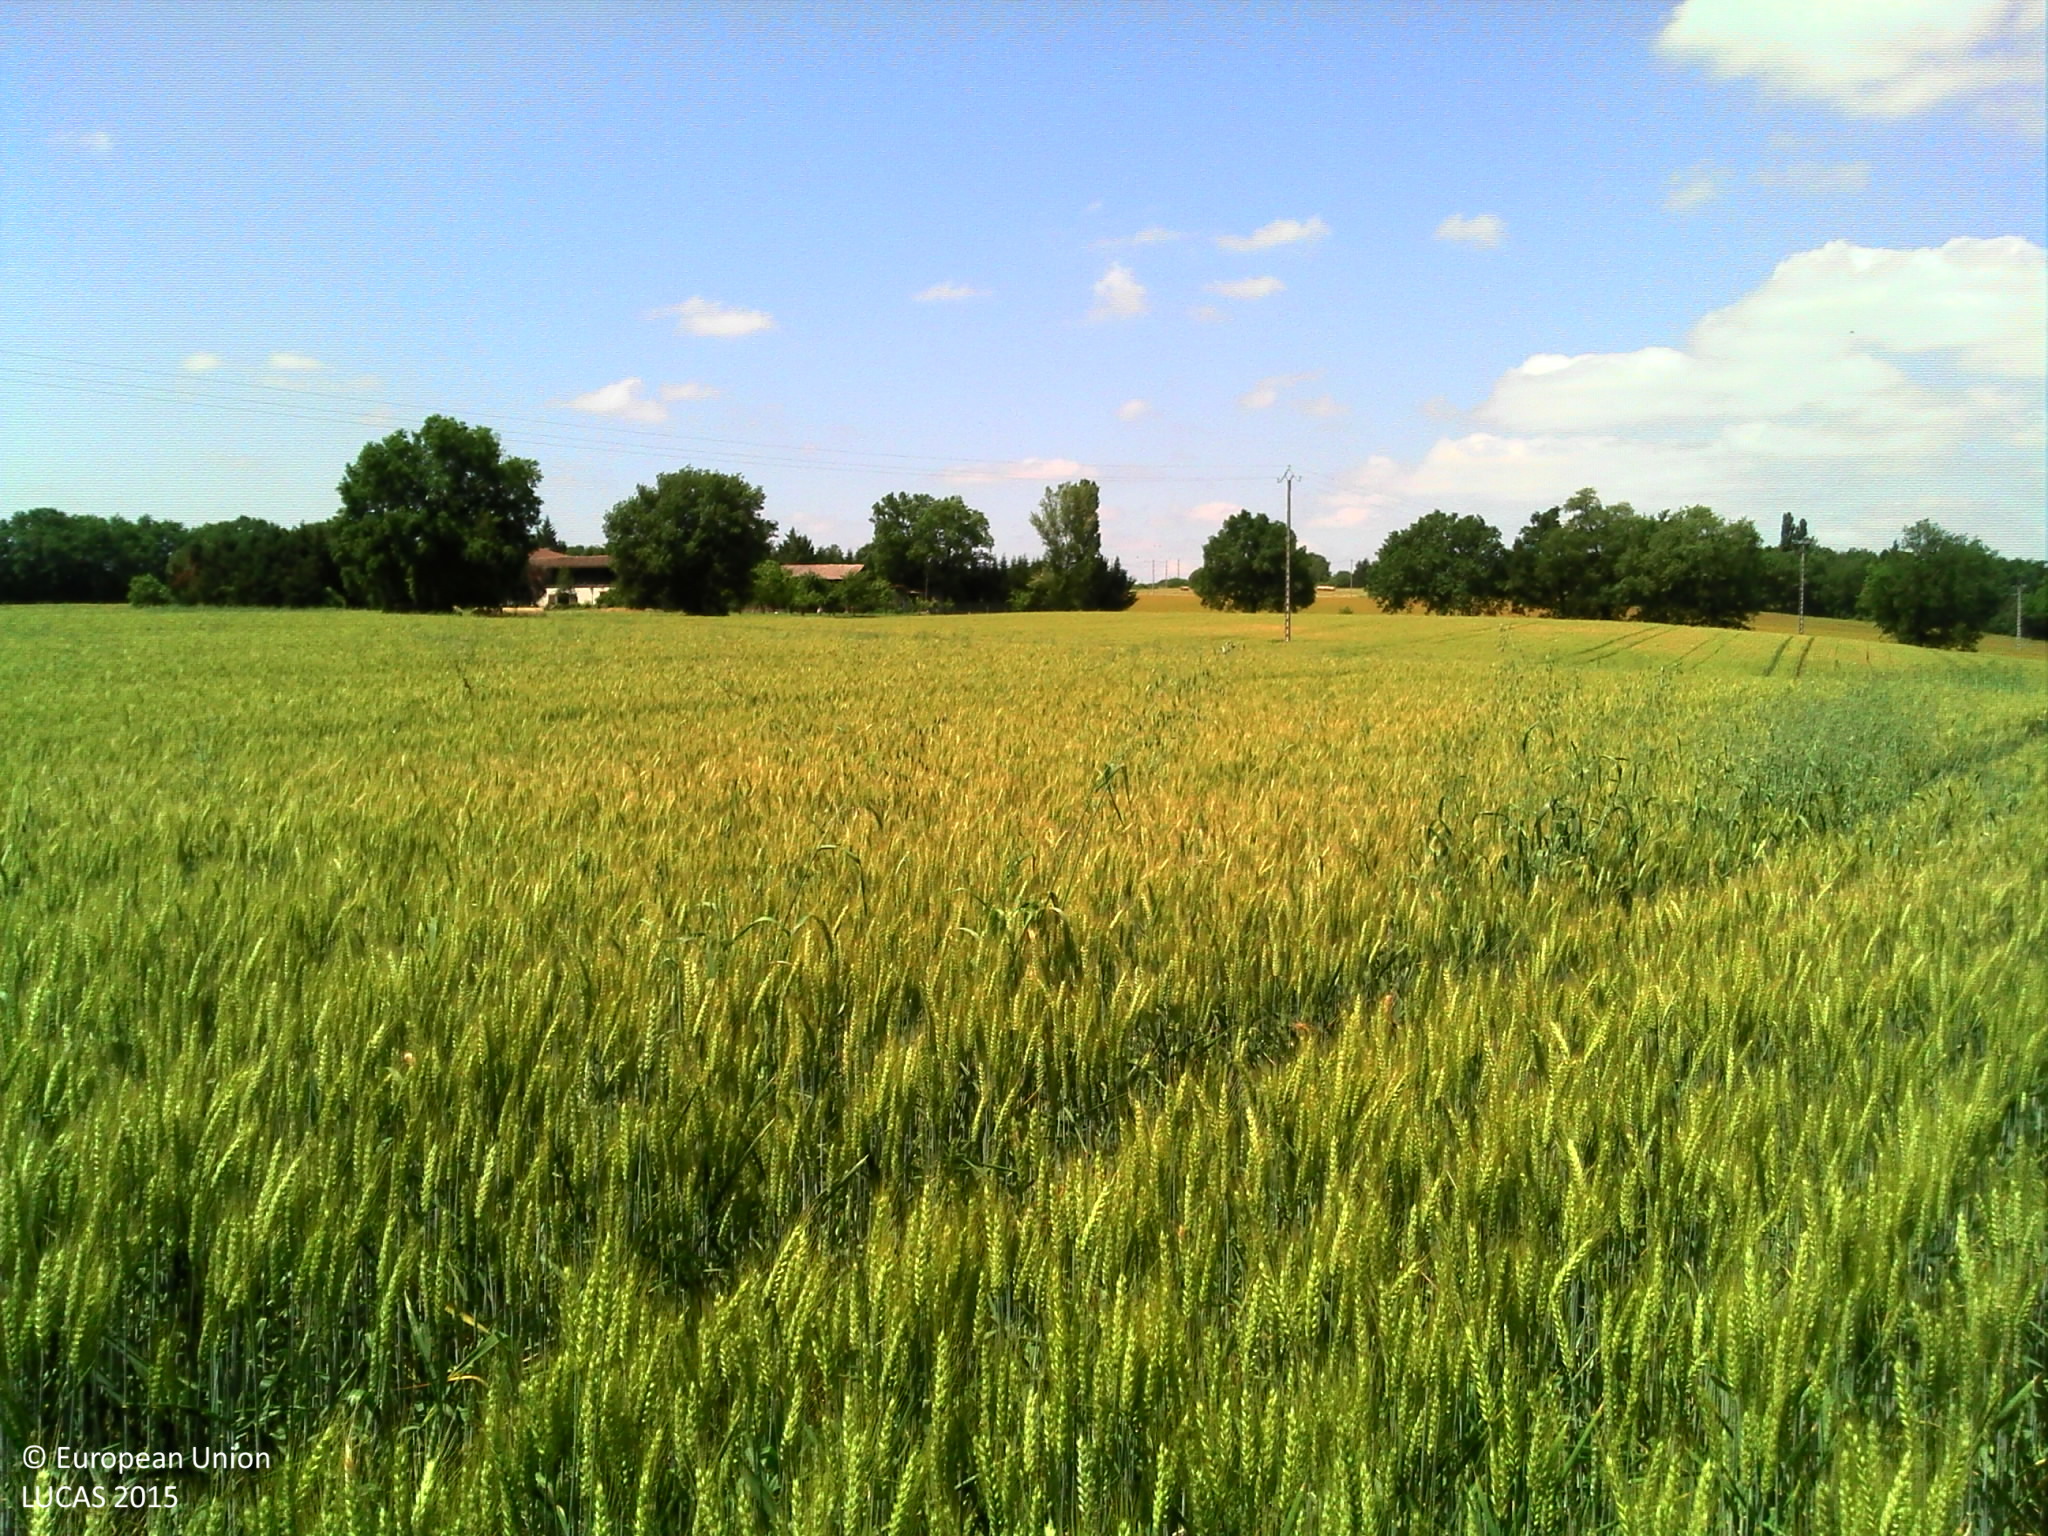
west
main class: Cropland
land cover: Common wheat
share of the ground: > 75 %
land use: Agriculture (excluding fallow land and kitchen gardens)
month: June
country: FR
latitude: 43.6295
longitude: 0.7653
